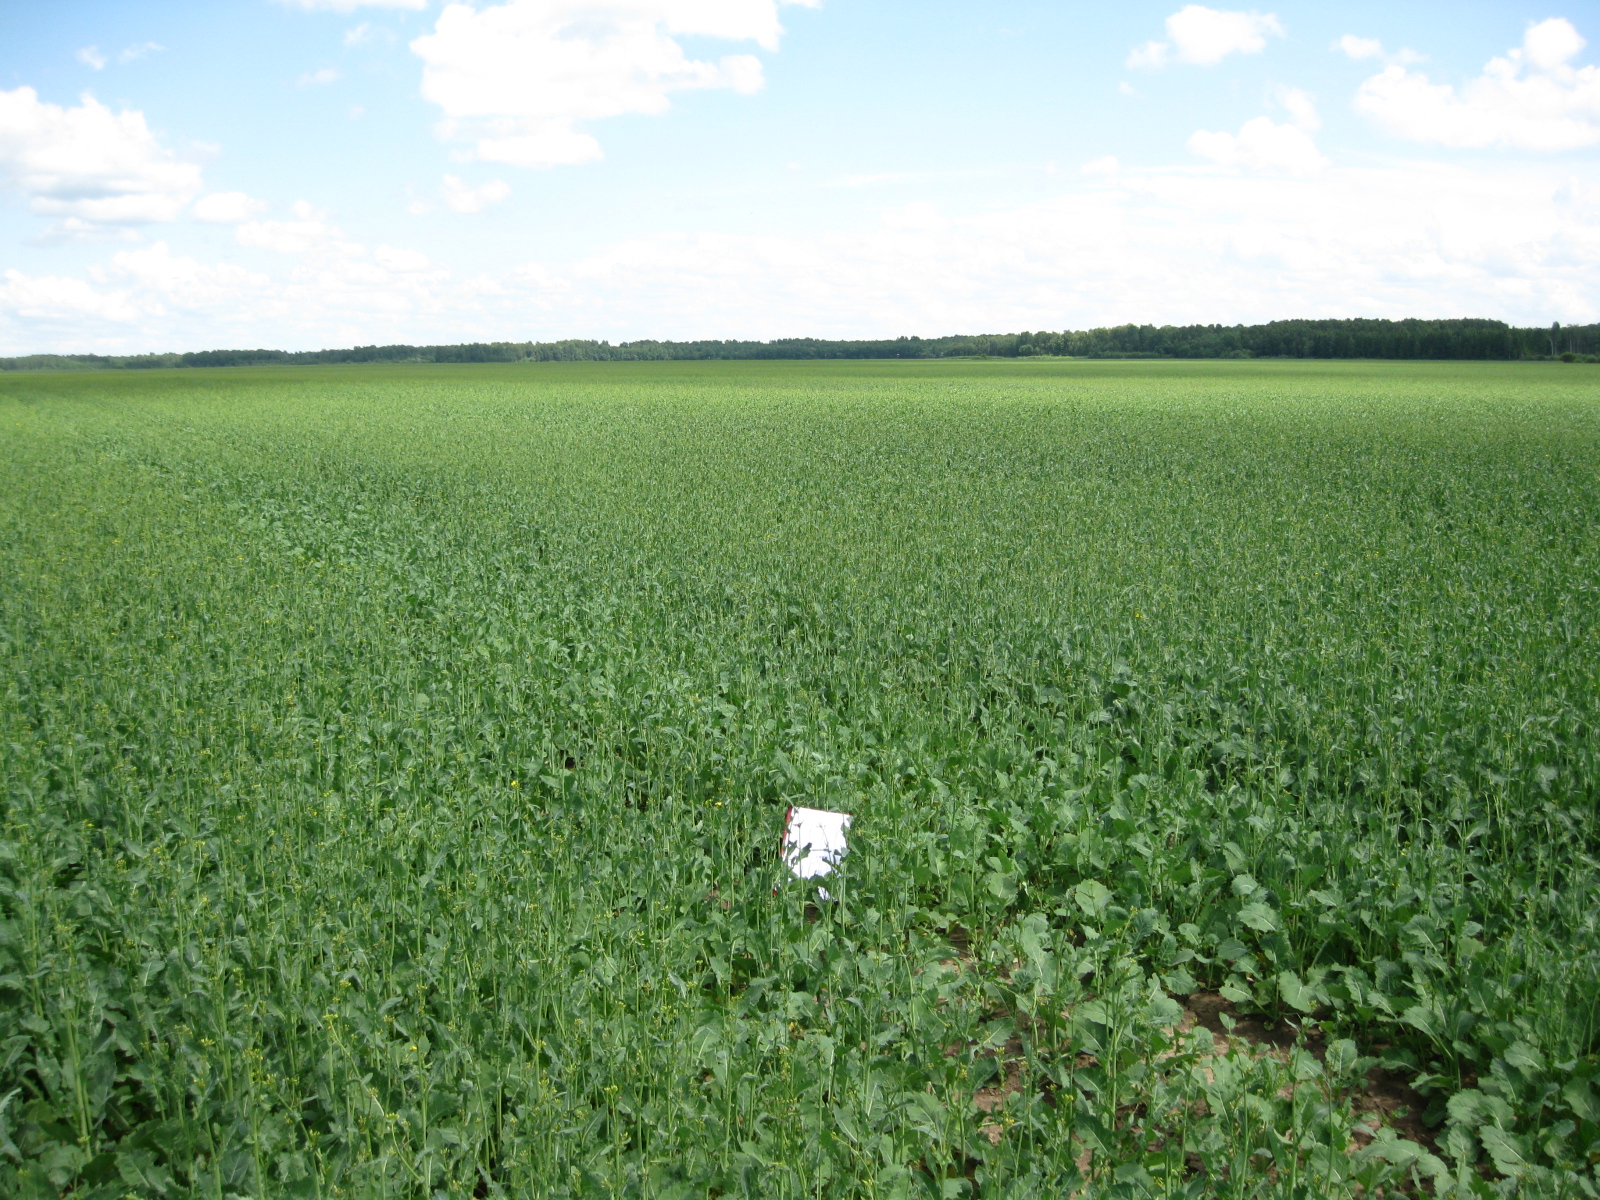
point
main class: Cropland
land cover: Rape and turnip rape
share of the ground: > 75 %
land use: Agriculture (excluding fallow land and kitchen gardens)
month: June
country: LT
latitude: 55.4073
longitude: 24.0682
